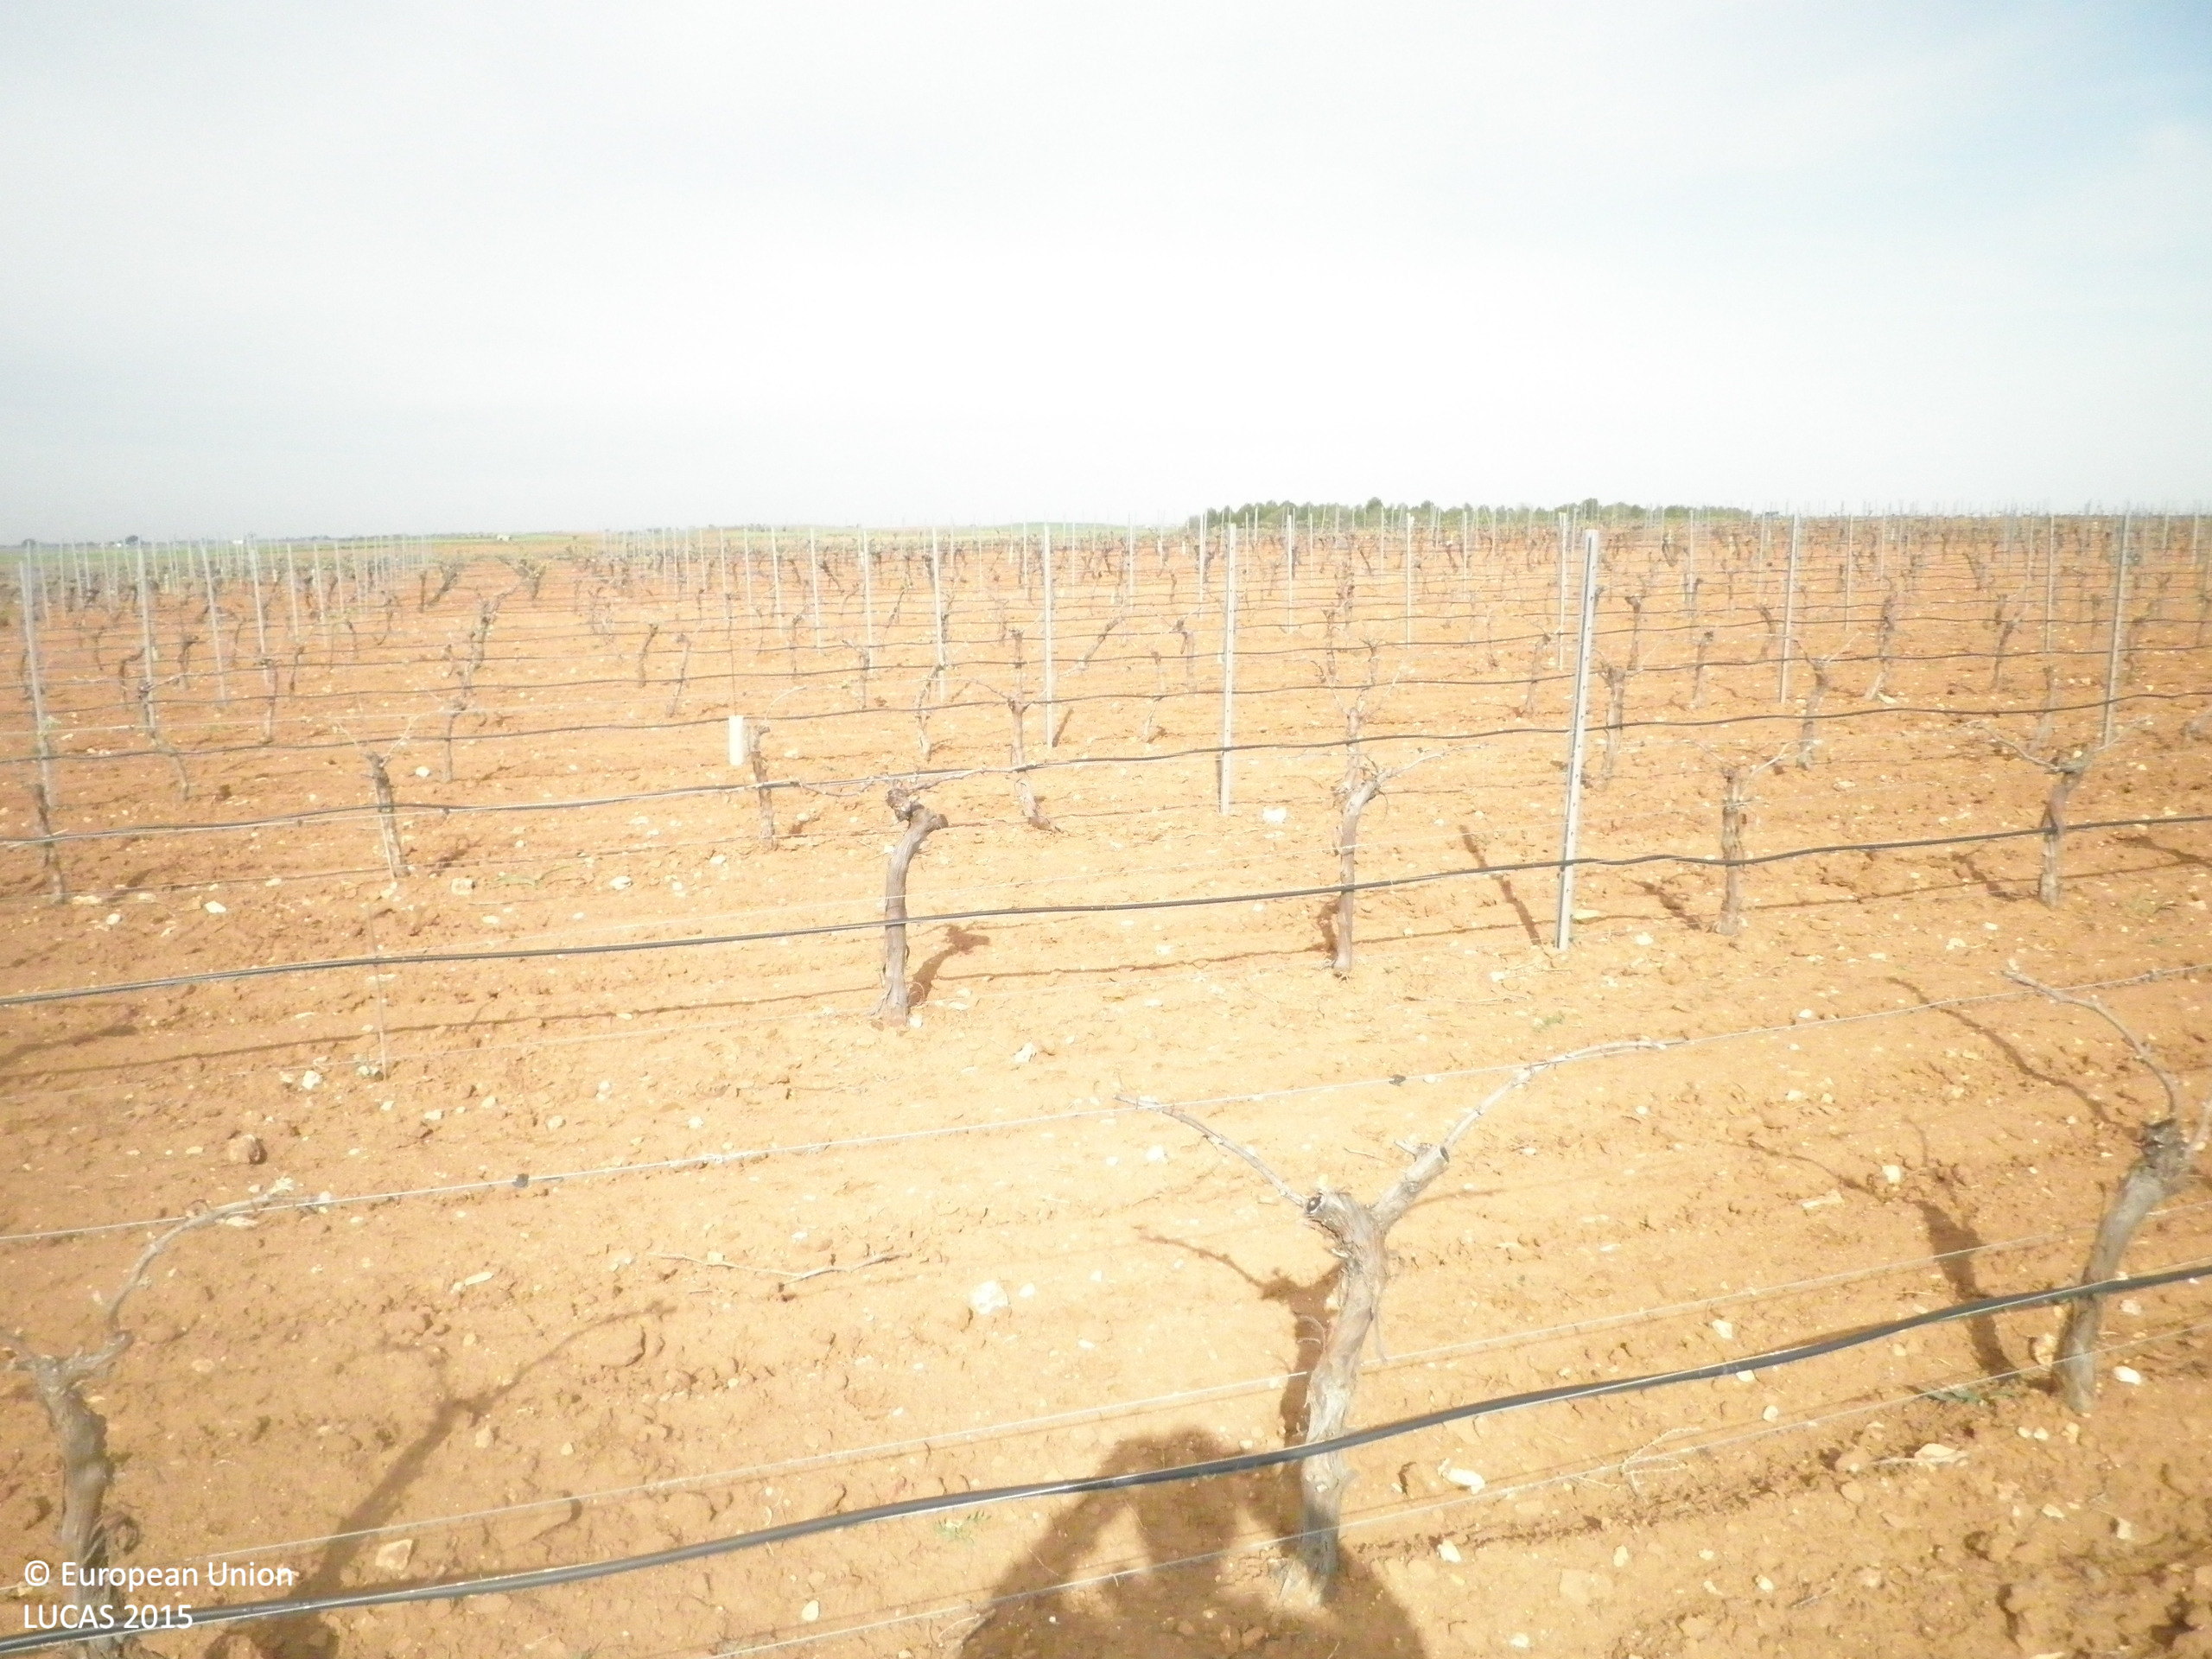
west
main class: Cropland
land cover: Vineyards
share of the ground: < 10 %
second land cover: Other bare soil
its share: > 75 %
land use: Agriculture (excluding fallow land and kitchen gardens)
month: April
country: ES
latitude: 39.3742
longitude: -2.7703
